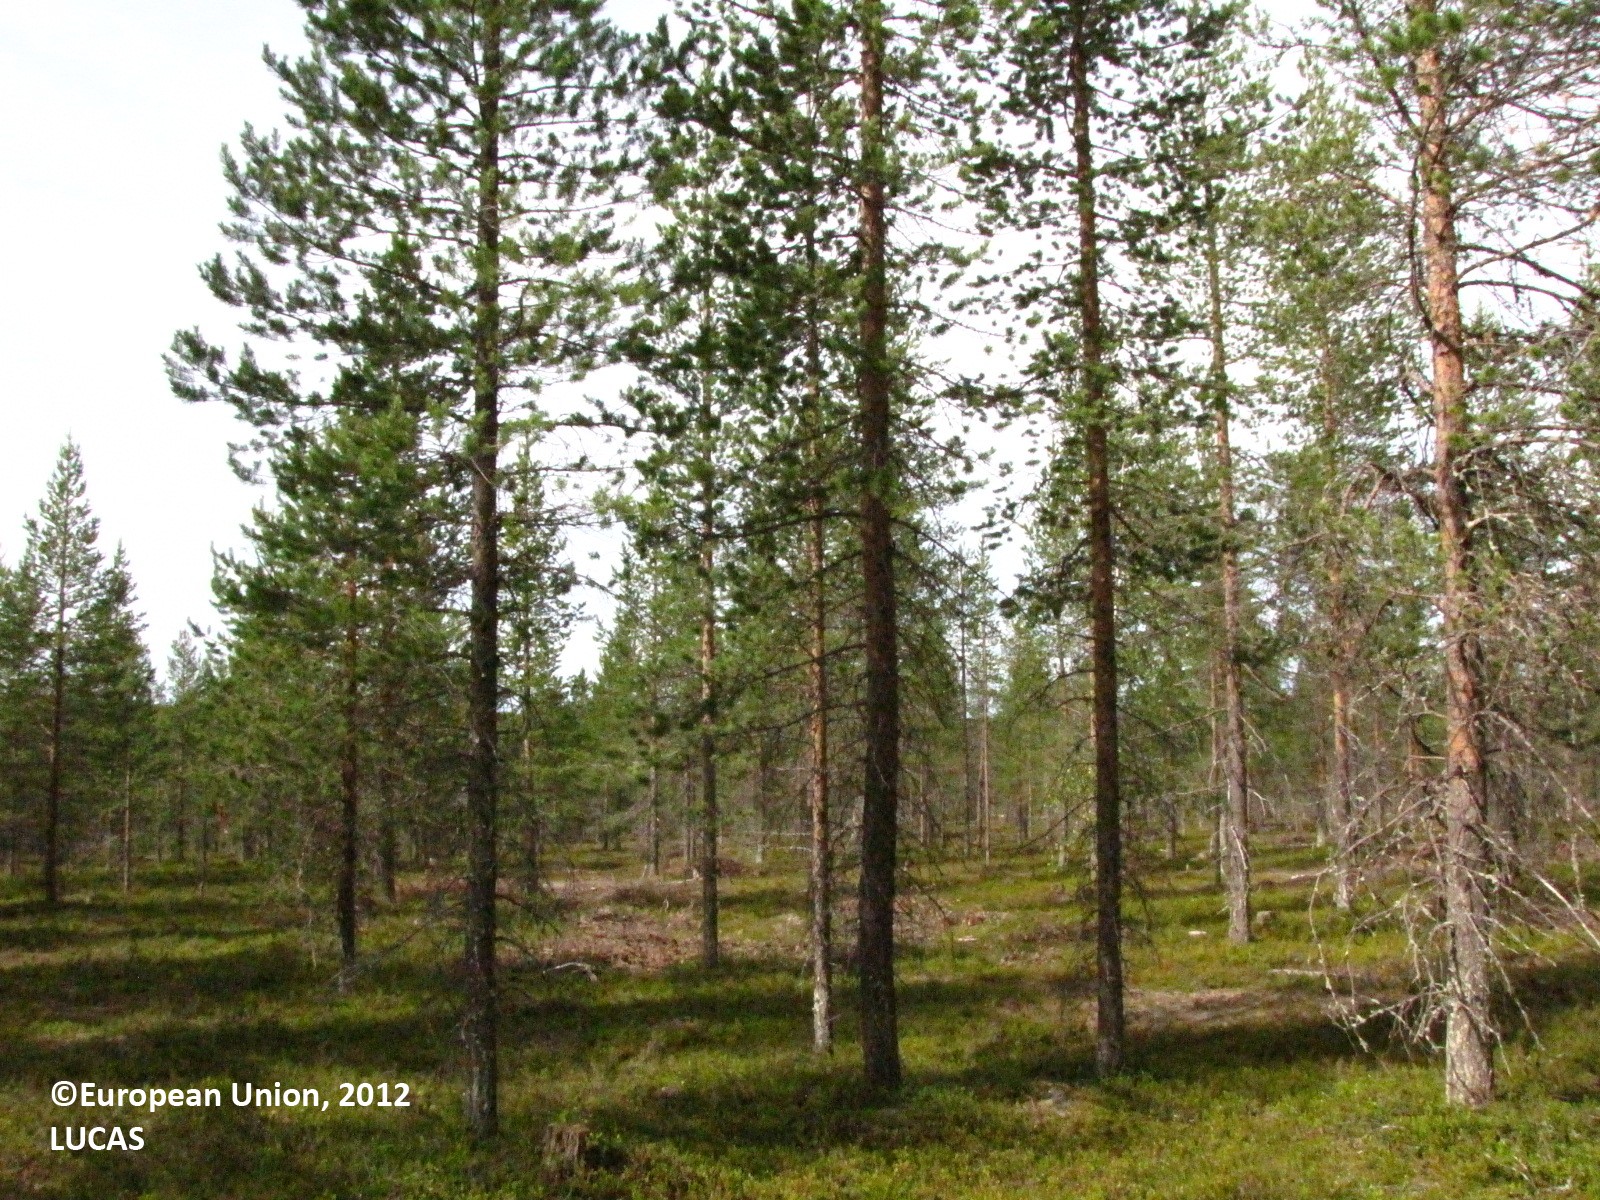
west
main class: Woodland
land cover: Pine dominated coniferous woodland
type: boreal forest
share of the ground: 50 - 75 %
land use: Forestry
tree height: > 5 m
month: July
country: FI
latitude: 66.6439
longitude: 25.1315
